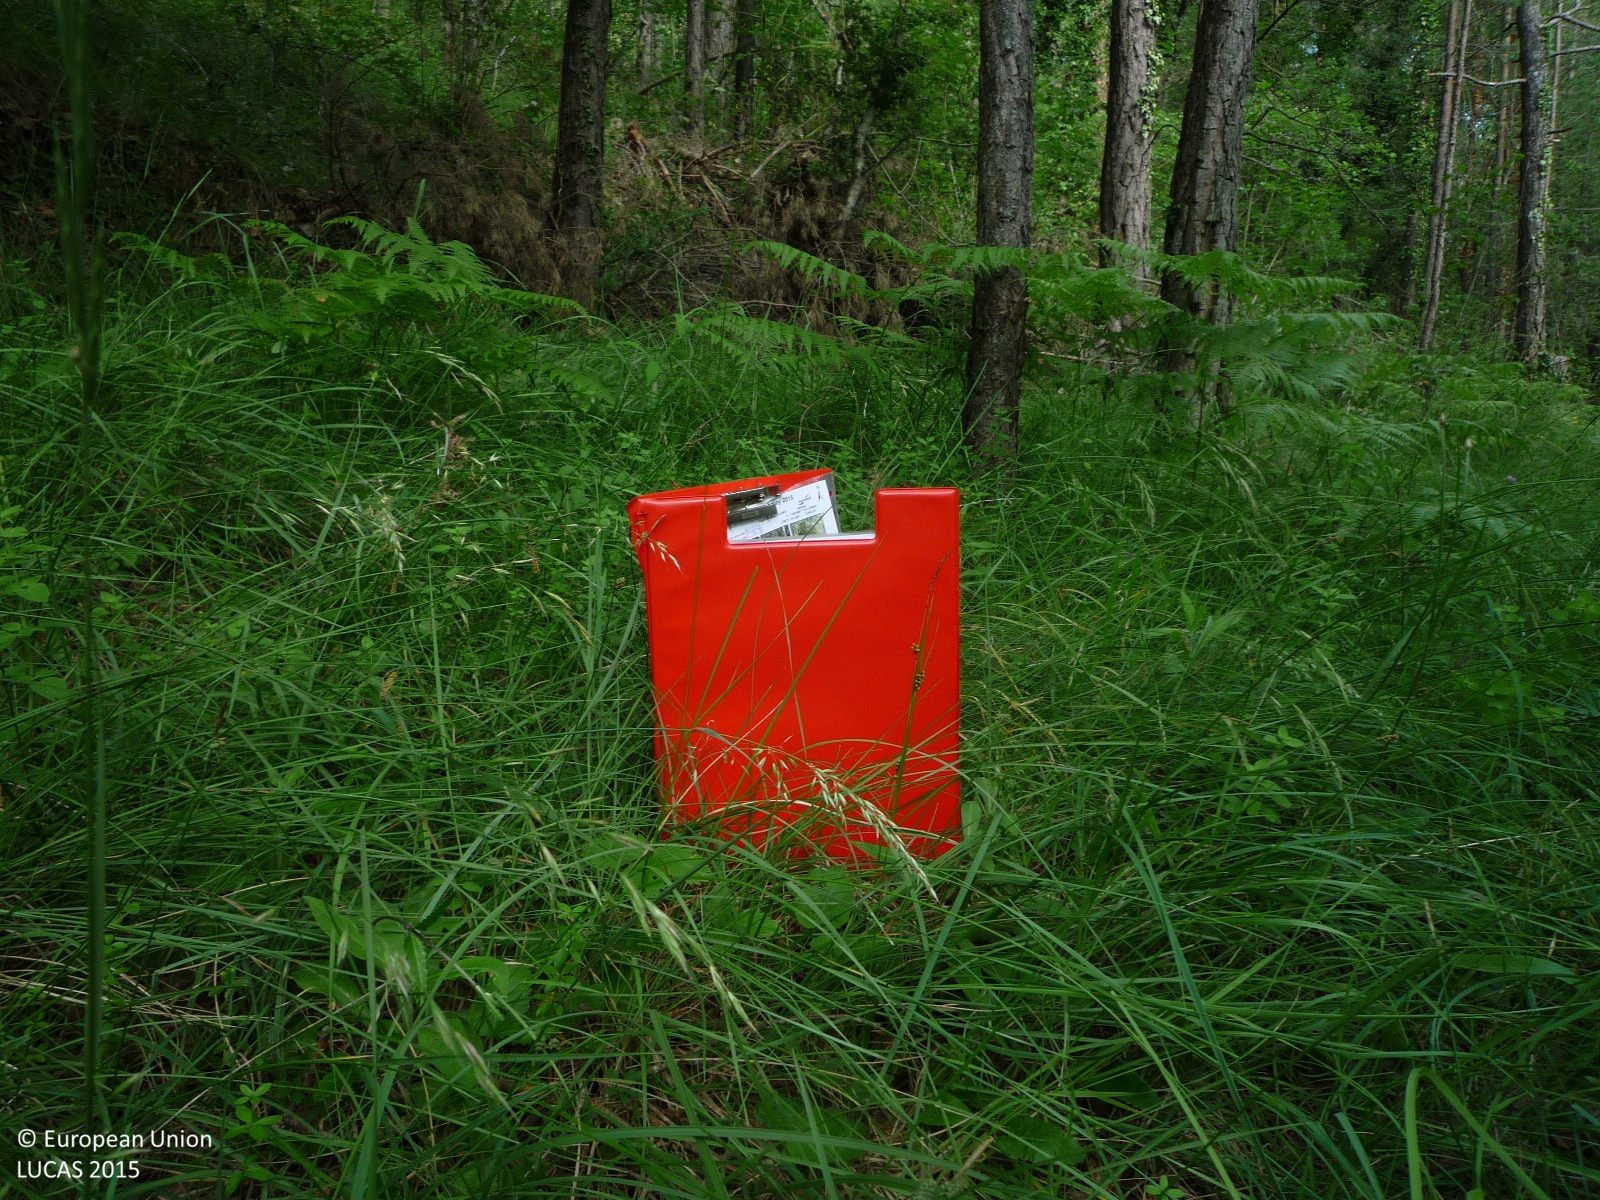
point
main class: Woodland
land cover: Pine dominated mixed woodland
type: coniferous forest of the mediterranean region
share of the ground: > 75 %
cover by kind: coniferous forest trees 60 %, broadleaved forest trees 30 %, herbaceous plants 10 %
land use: Forestry
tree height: > 5 m
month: June
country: ES
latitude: 42.1350
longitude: 1.9676
